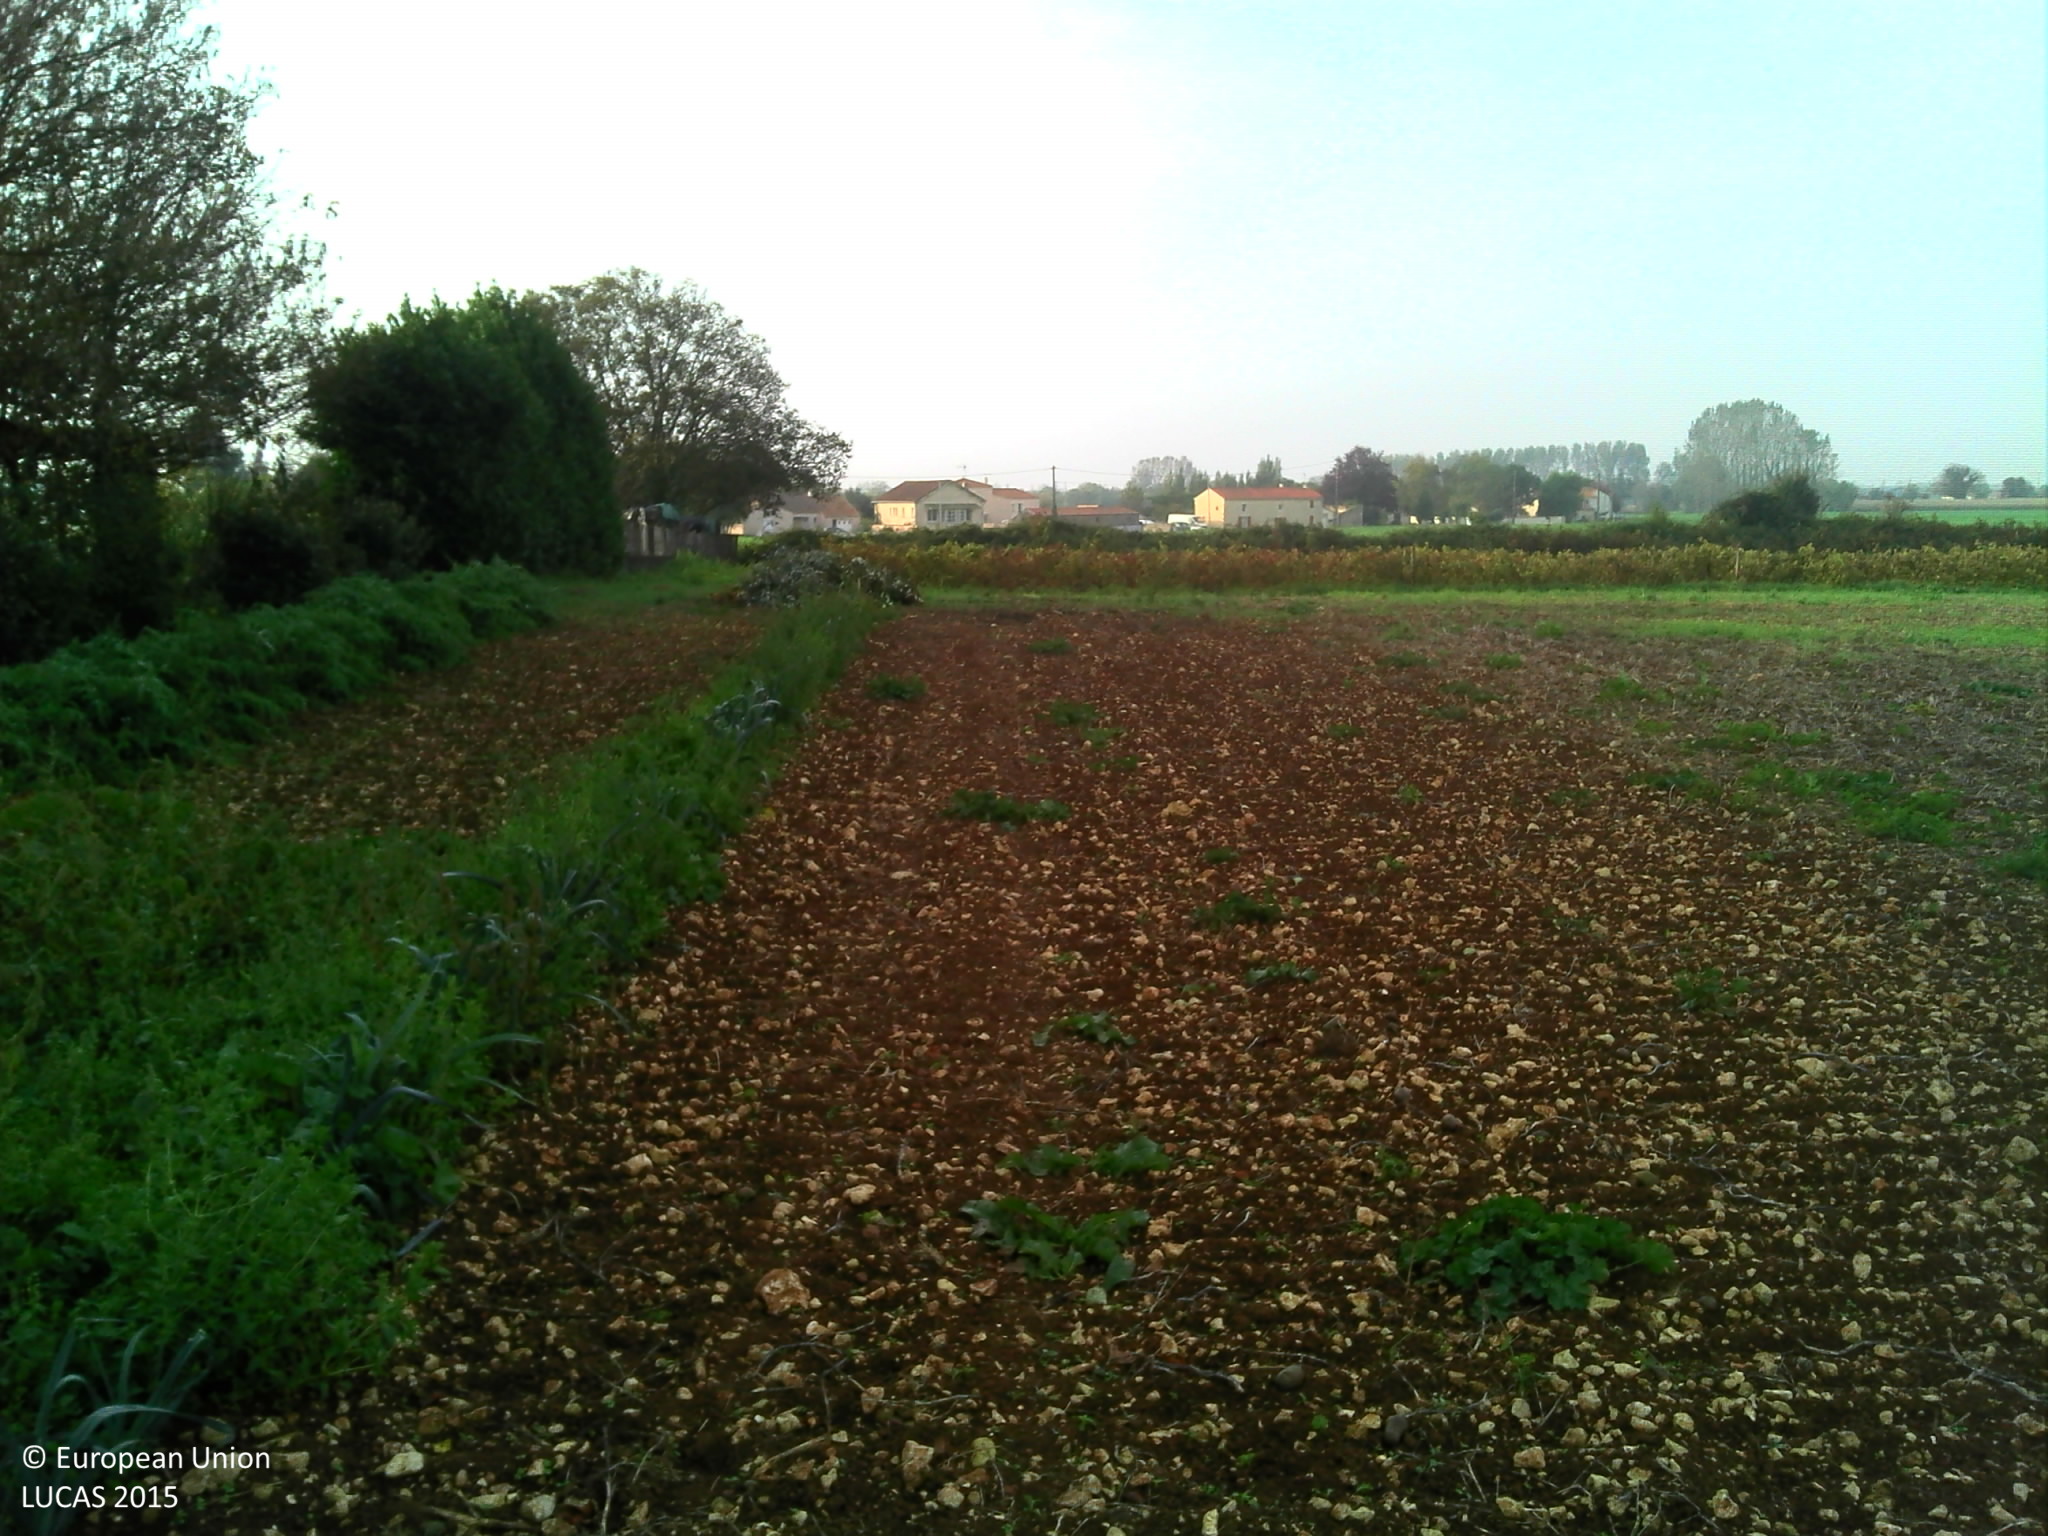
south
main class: Grassland
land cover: Spontaneously vegetated surfaces
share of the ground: 25 - 50 %
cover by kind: unconsolidated bare surface 85 %, herbaceous plants 15 %
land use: Fallow land
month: October
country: FR
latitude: 46.4688
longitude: -1.0364
